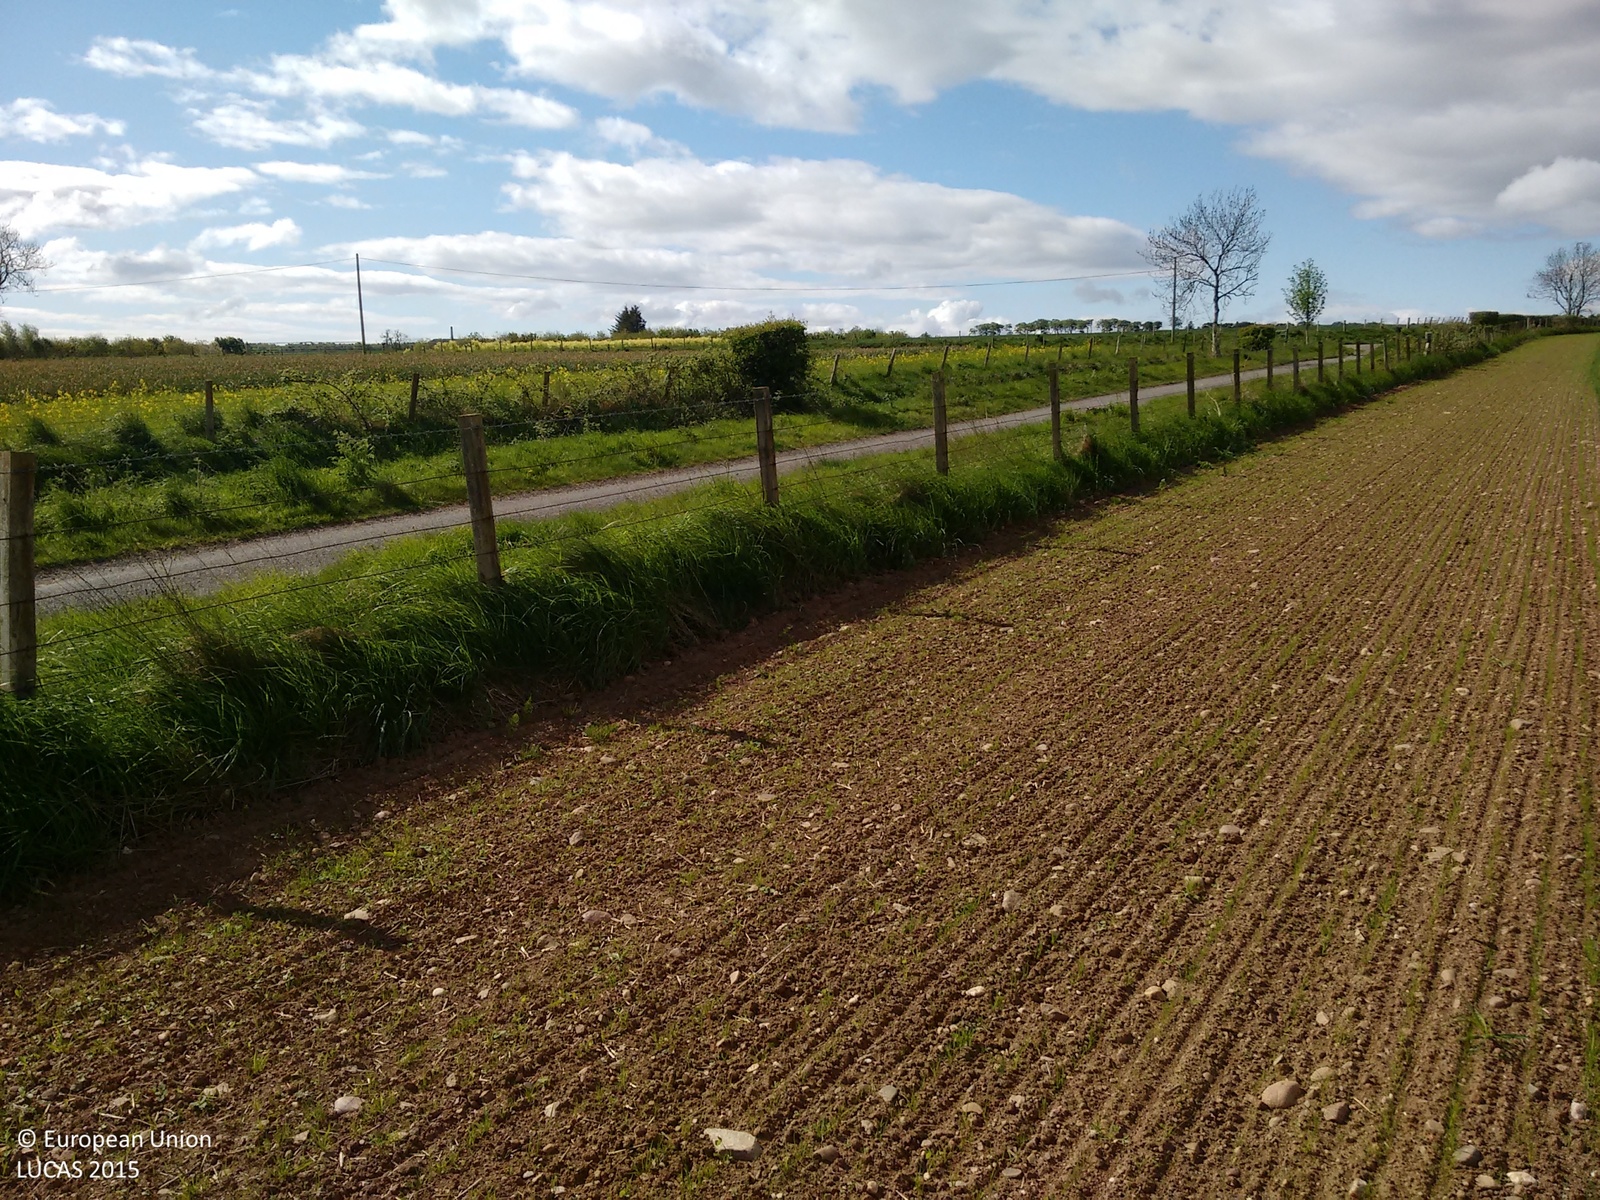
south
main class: Cropland
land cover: Barley
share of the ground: > 75 %
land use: Agriculture (excluding fallow land and kitchen gardens)
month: May
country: GB
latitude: 56.7722
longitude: -2.5416
